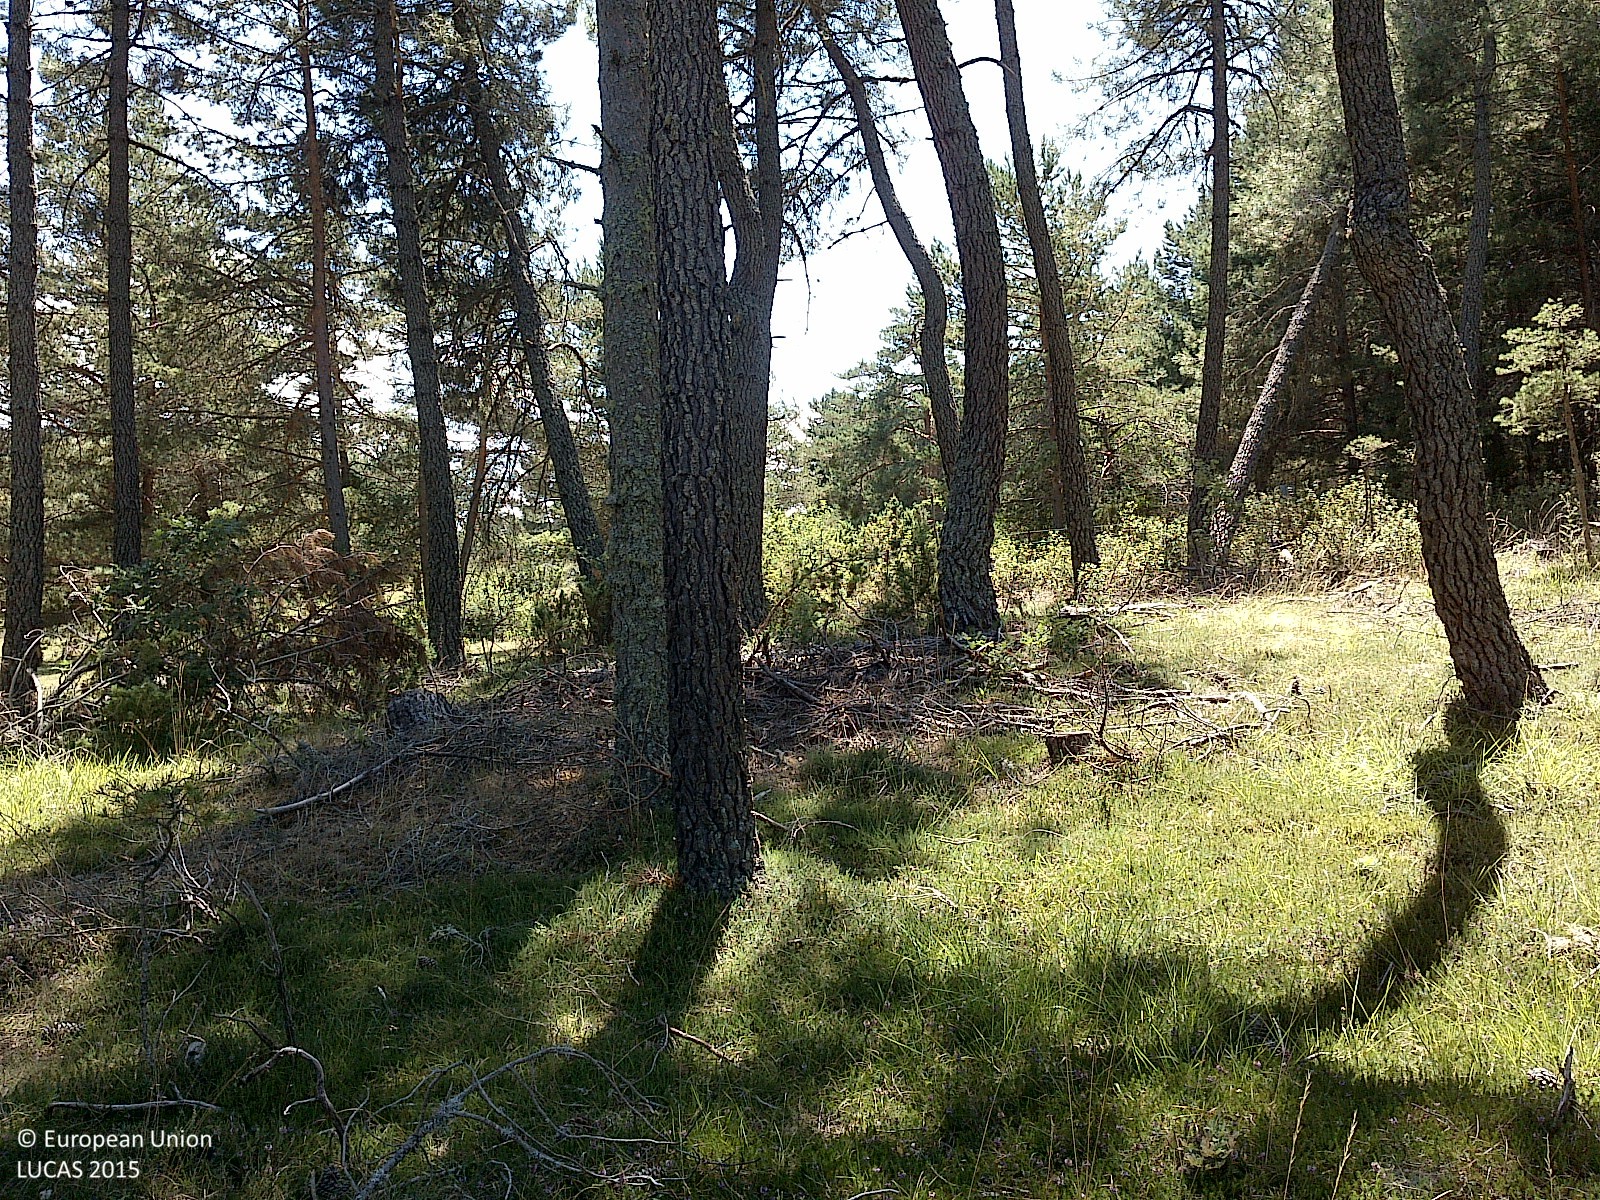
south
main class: Woodland
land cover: Pine dominated coniferous woodland
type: coniferous forest of the mediterranean region
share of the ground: > 75 %
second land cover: Grassland without tree/shrub cover
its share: 50 - 75 %
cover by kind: coniferous forest trees 80 %, herbaceous plants 15 %, shrubs 5 %
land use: Forestry
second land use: Agriculture (excluding fallow land and kitchen gardens)
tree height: > 5 m
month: July
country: ES
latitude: 41.8812
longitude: -3.1708
